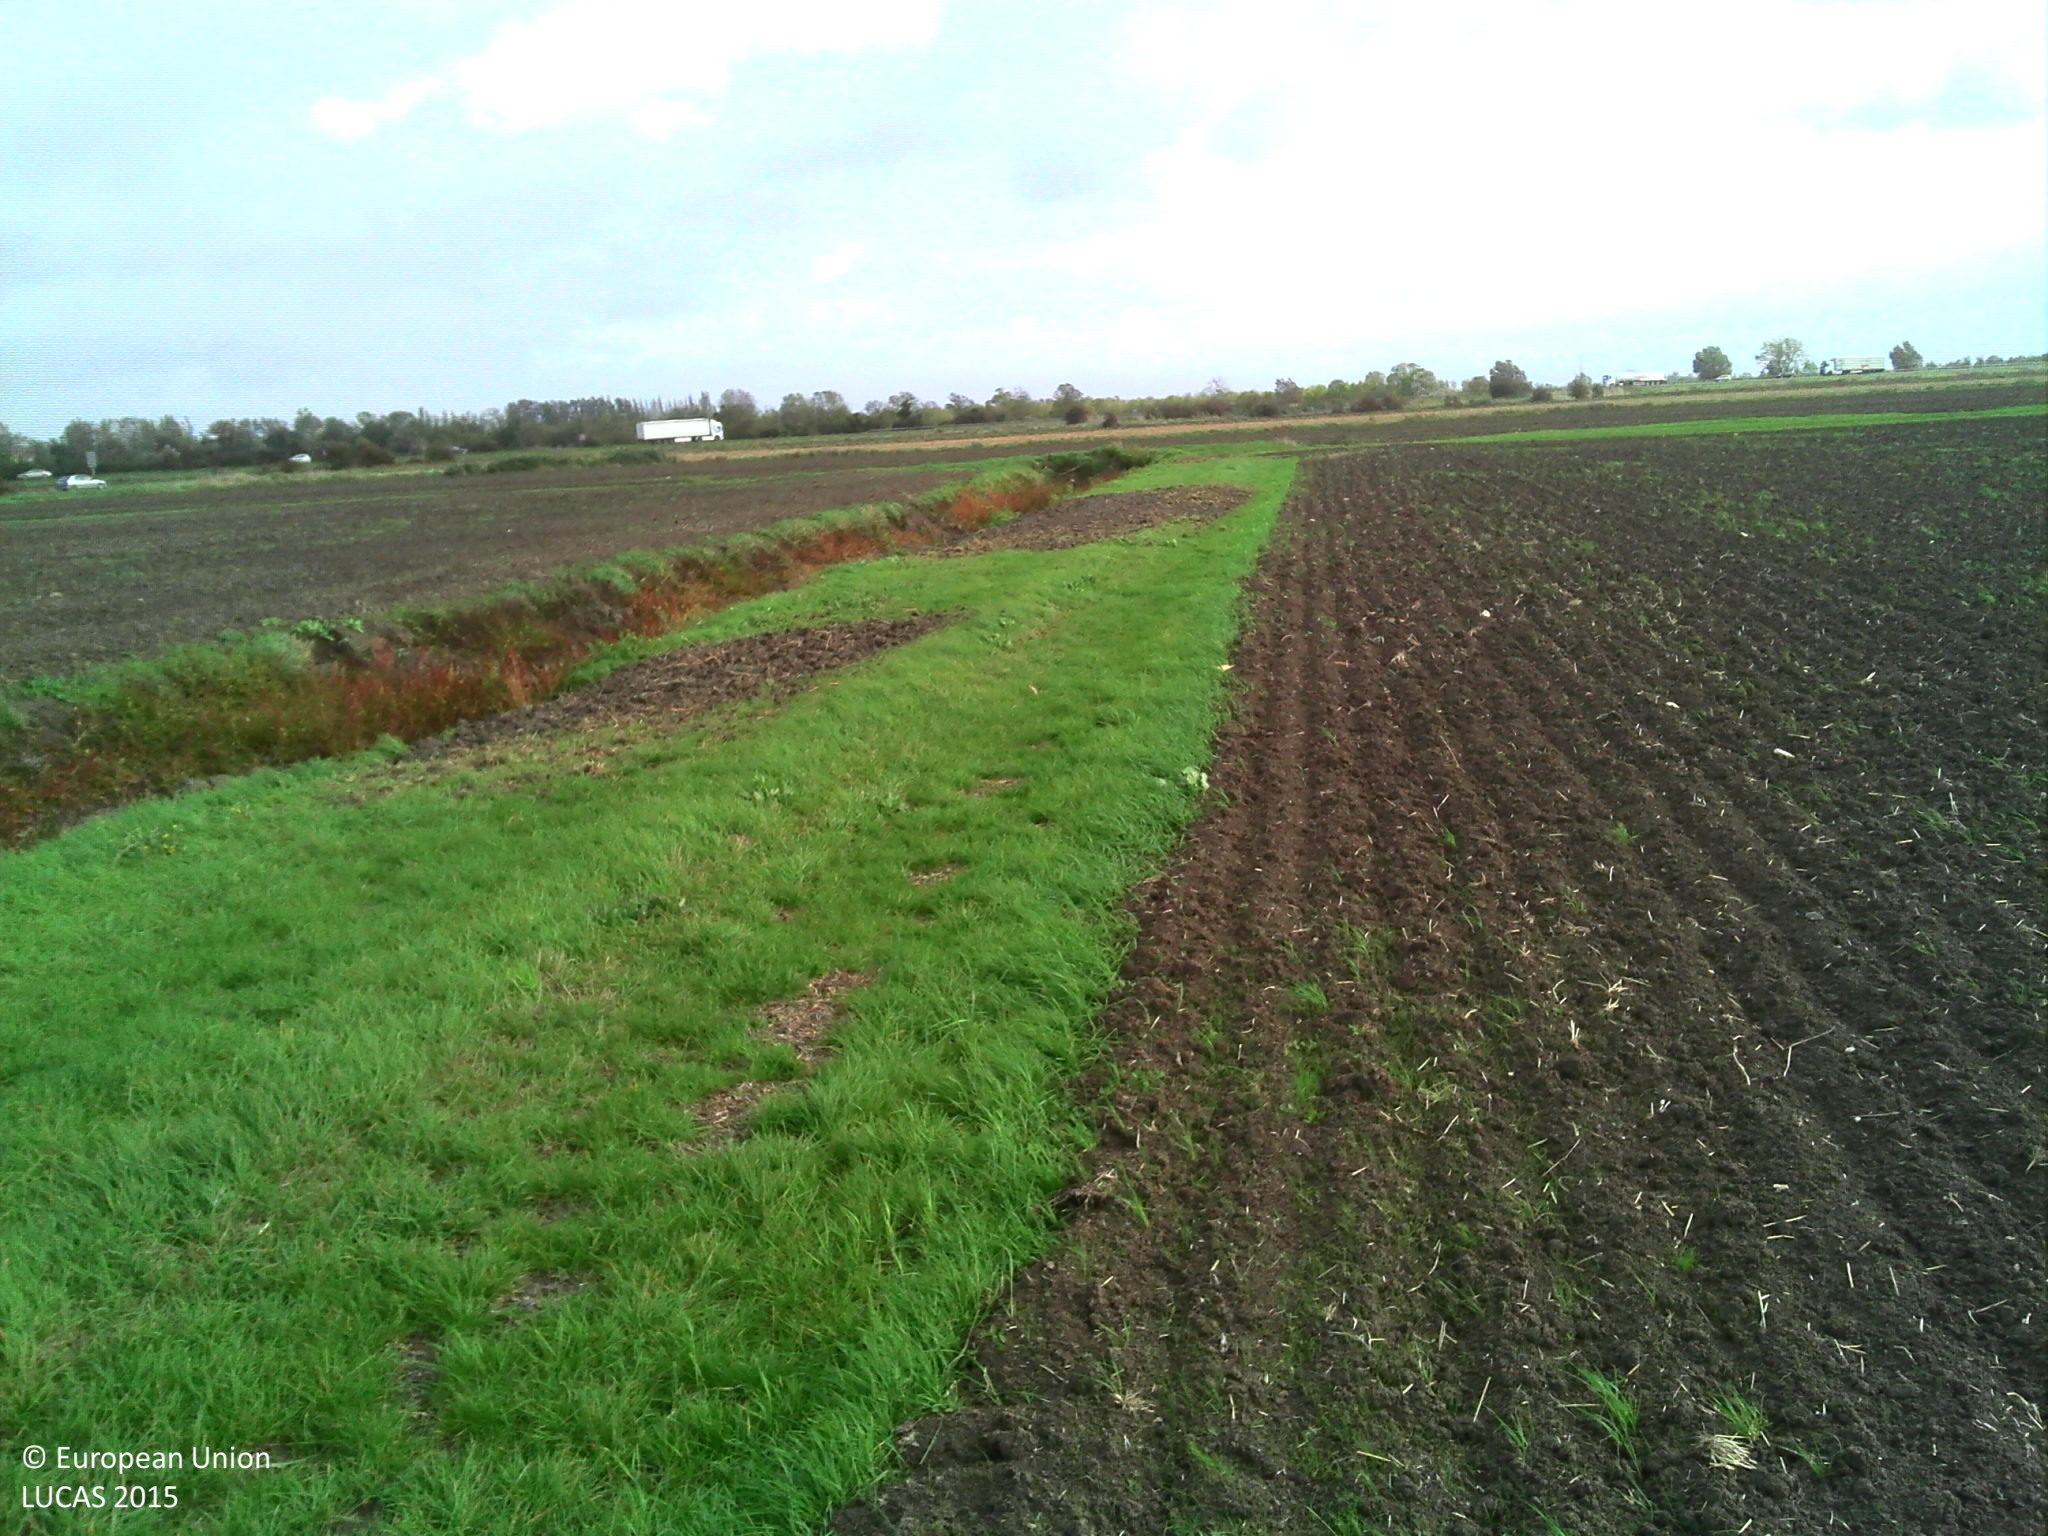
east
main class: Grassland
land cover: Grassland without tree/shrub cover
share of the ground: < 10 %
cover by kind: herbaceous plants 100 %
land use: Agriculture (excluding fallow land and kitchen gardens)
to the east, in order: Grassland without tree/shrub cover; Inland fresh running water; Grass margins; Other bare soil; Ditches and canals; Tracks; Grass margins; Ditches and canals; Spontaneously vegetated surfaces; Ditches and canals; Maize; Ditches and canals; Maize; Ditches and canals; Maize; Ditches and canals; Maize; Ditches and canals; Other bare soil
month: October
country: FR
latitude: 46.3718
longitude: -1.0951
